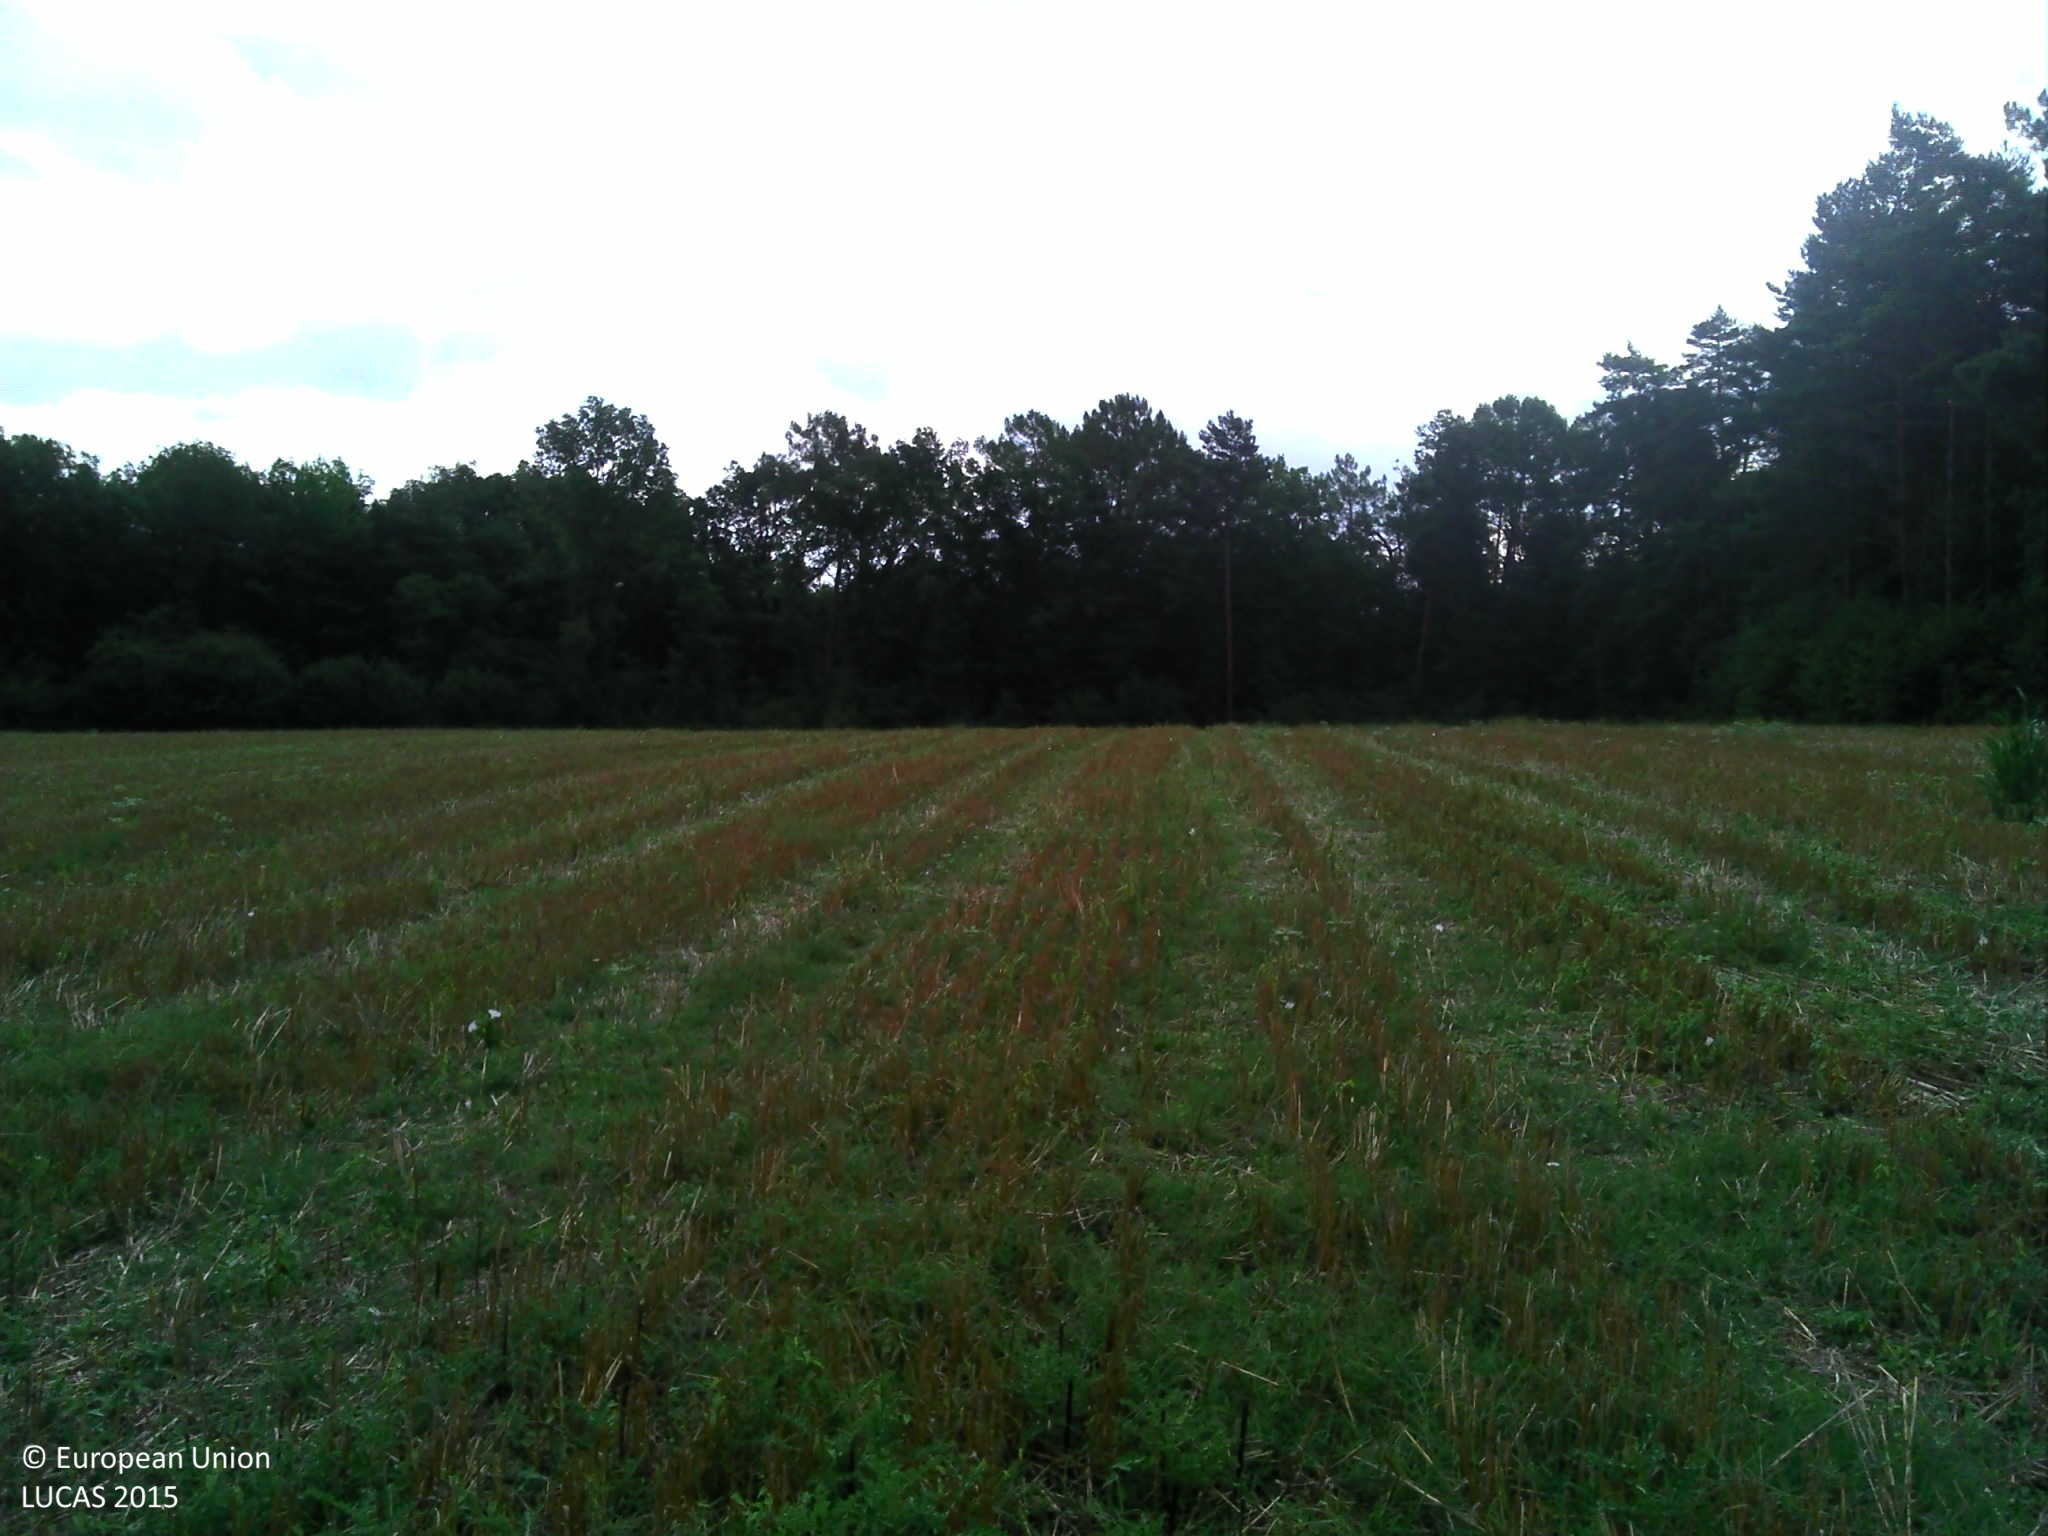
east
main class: Cropland
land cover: Temporary grasslands
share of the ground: > 75 %
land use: Agriculture (excluding fallow land and kitchen gardens)
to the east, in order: Temporary grasslands; Broadleaved woodland; Tracks; Broadleaved woodland; Grass margins; Paved roads, cycling and walking lanes; Grass margins; Ditches and canals; Grassland without tree/shrub cover
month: August
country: FR
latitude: 45.3881
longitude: 0.7550
